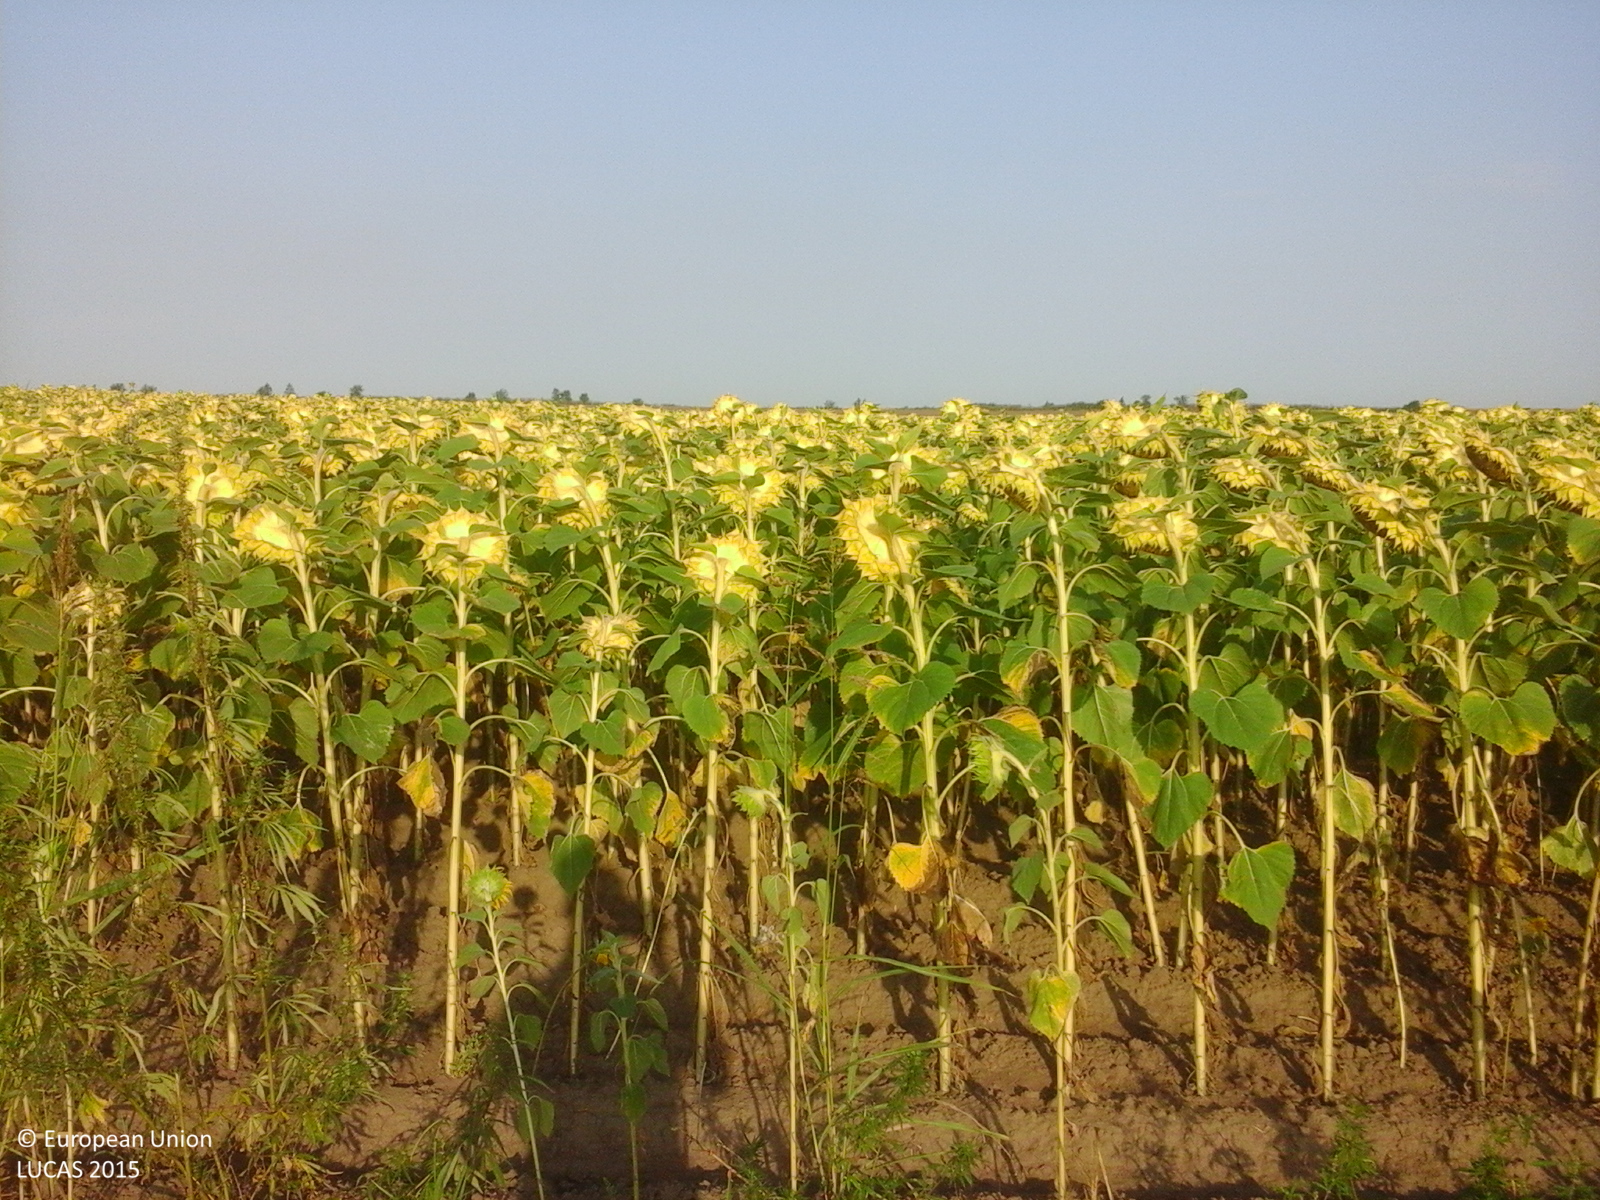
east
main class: Cropland
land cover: Sunflower
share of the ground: > 75 %
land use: Agriculture (excluding fallow land and kitchen gardens)
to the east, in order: Sunflower; Common wheat; Other bare soil
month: August
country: RO
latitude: 44.0624
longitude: 28.0435
